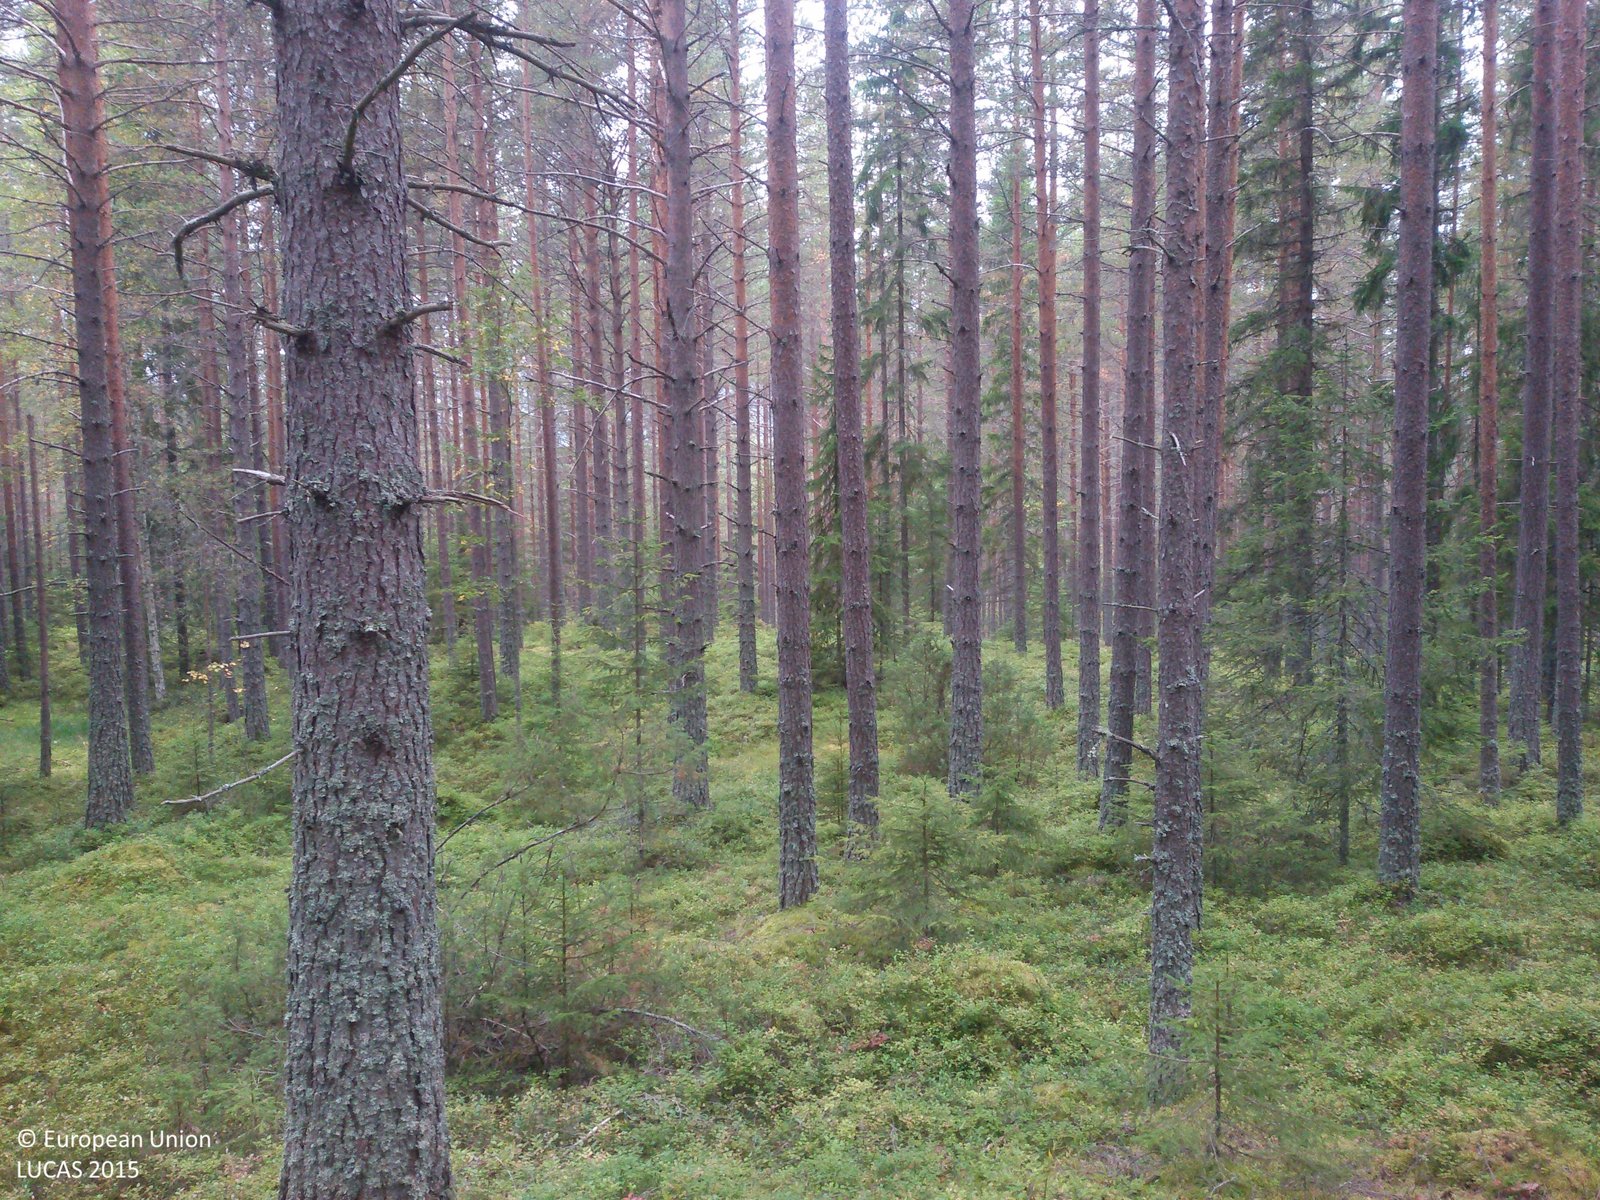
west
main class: Woodland
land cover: Pine dominated coniferous woodland
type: boreal forest
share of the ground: > 75 %
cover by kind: coniferous forest trees 75 %, shrubs 15 %, lichens and mosses 10 %
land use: Forestry
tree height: > 5 m
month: September
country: SE
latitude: 61.0709
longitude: 14.3047
